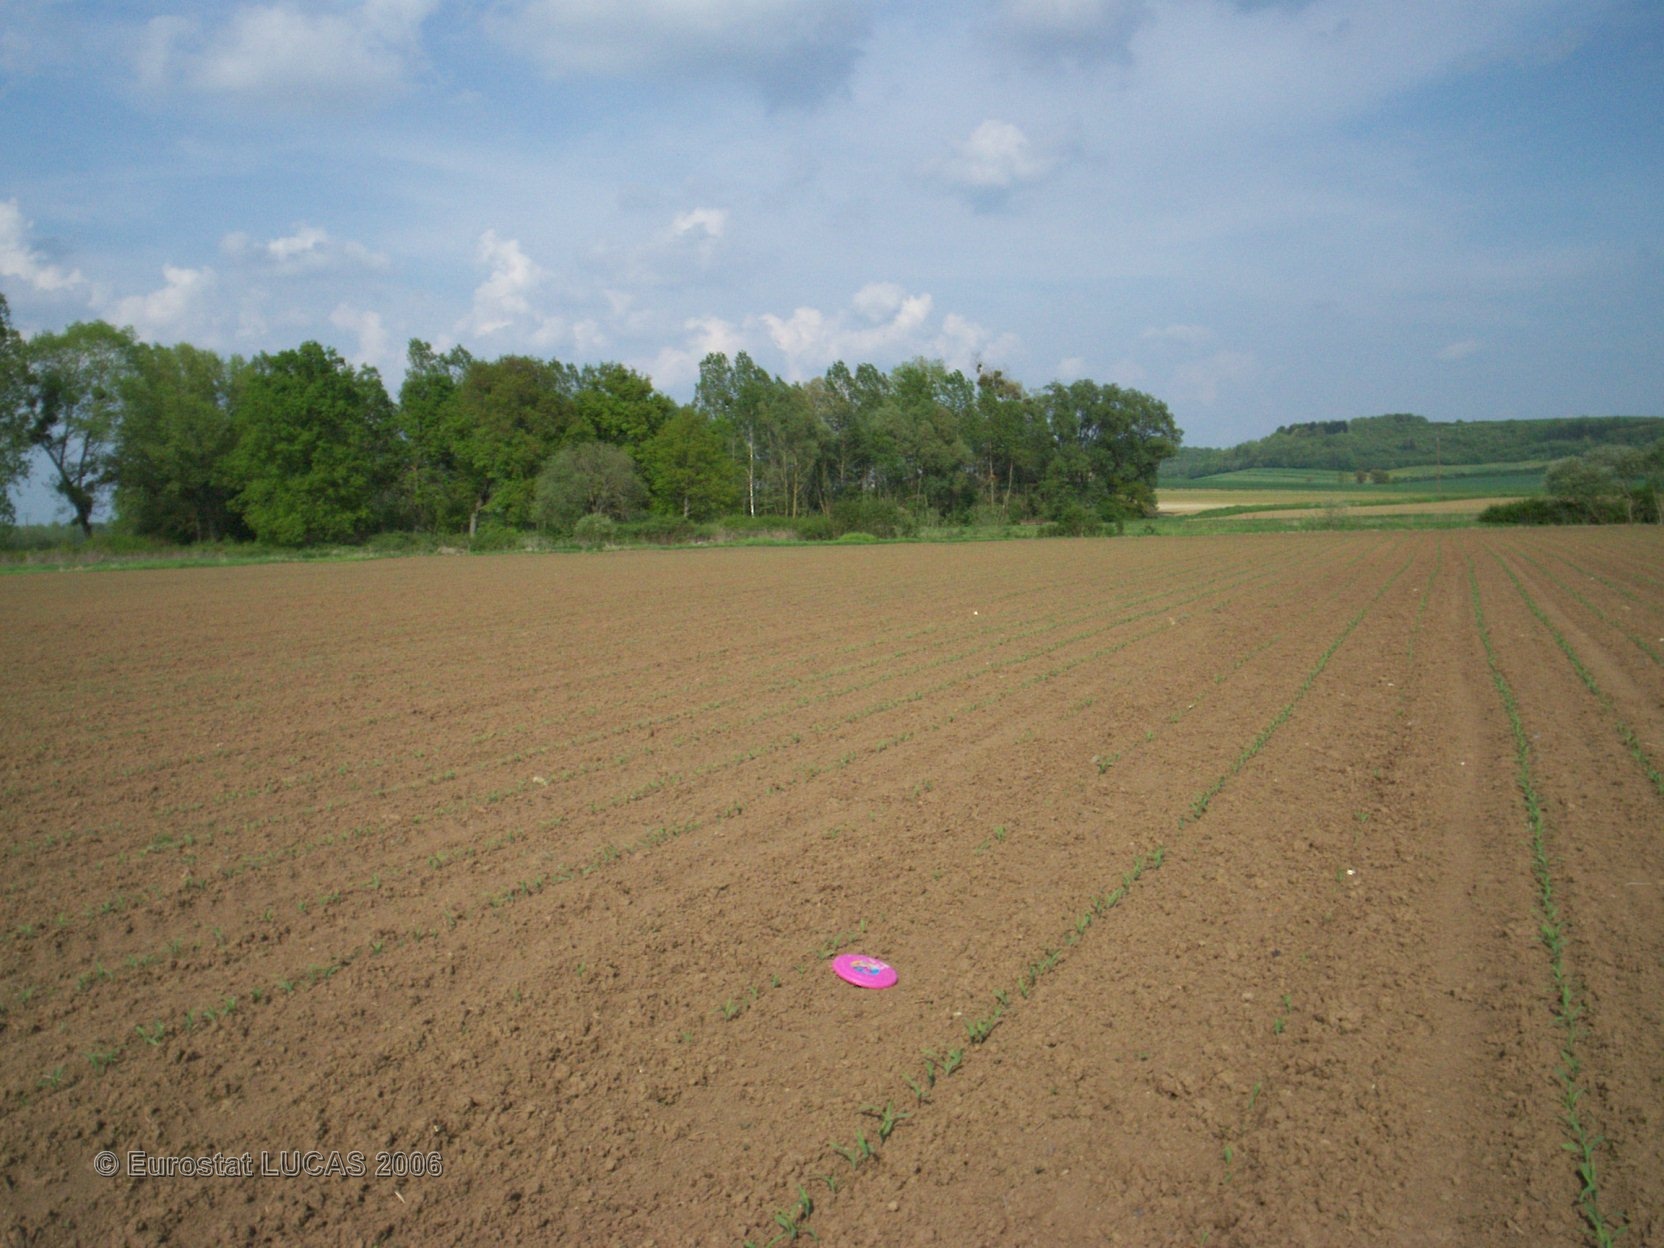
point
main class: Cropland
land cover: Maize
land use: Agriculture (excluding fallow land and kitchen gardens)
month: May
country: FR
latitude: 49.5915
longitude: 4.3099
